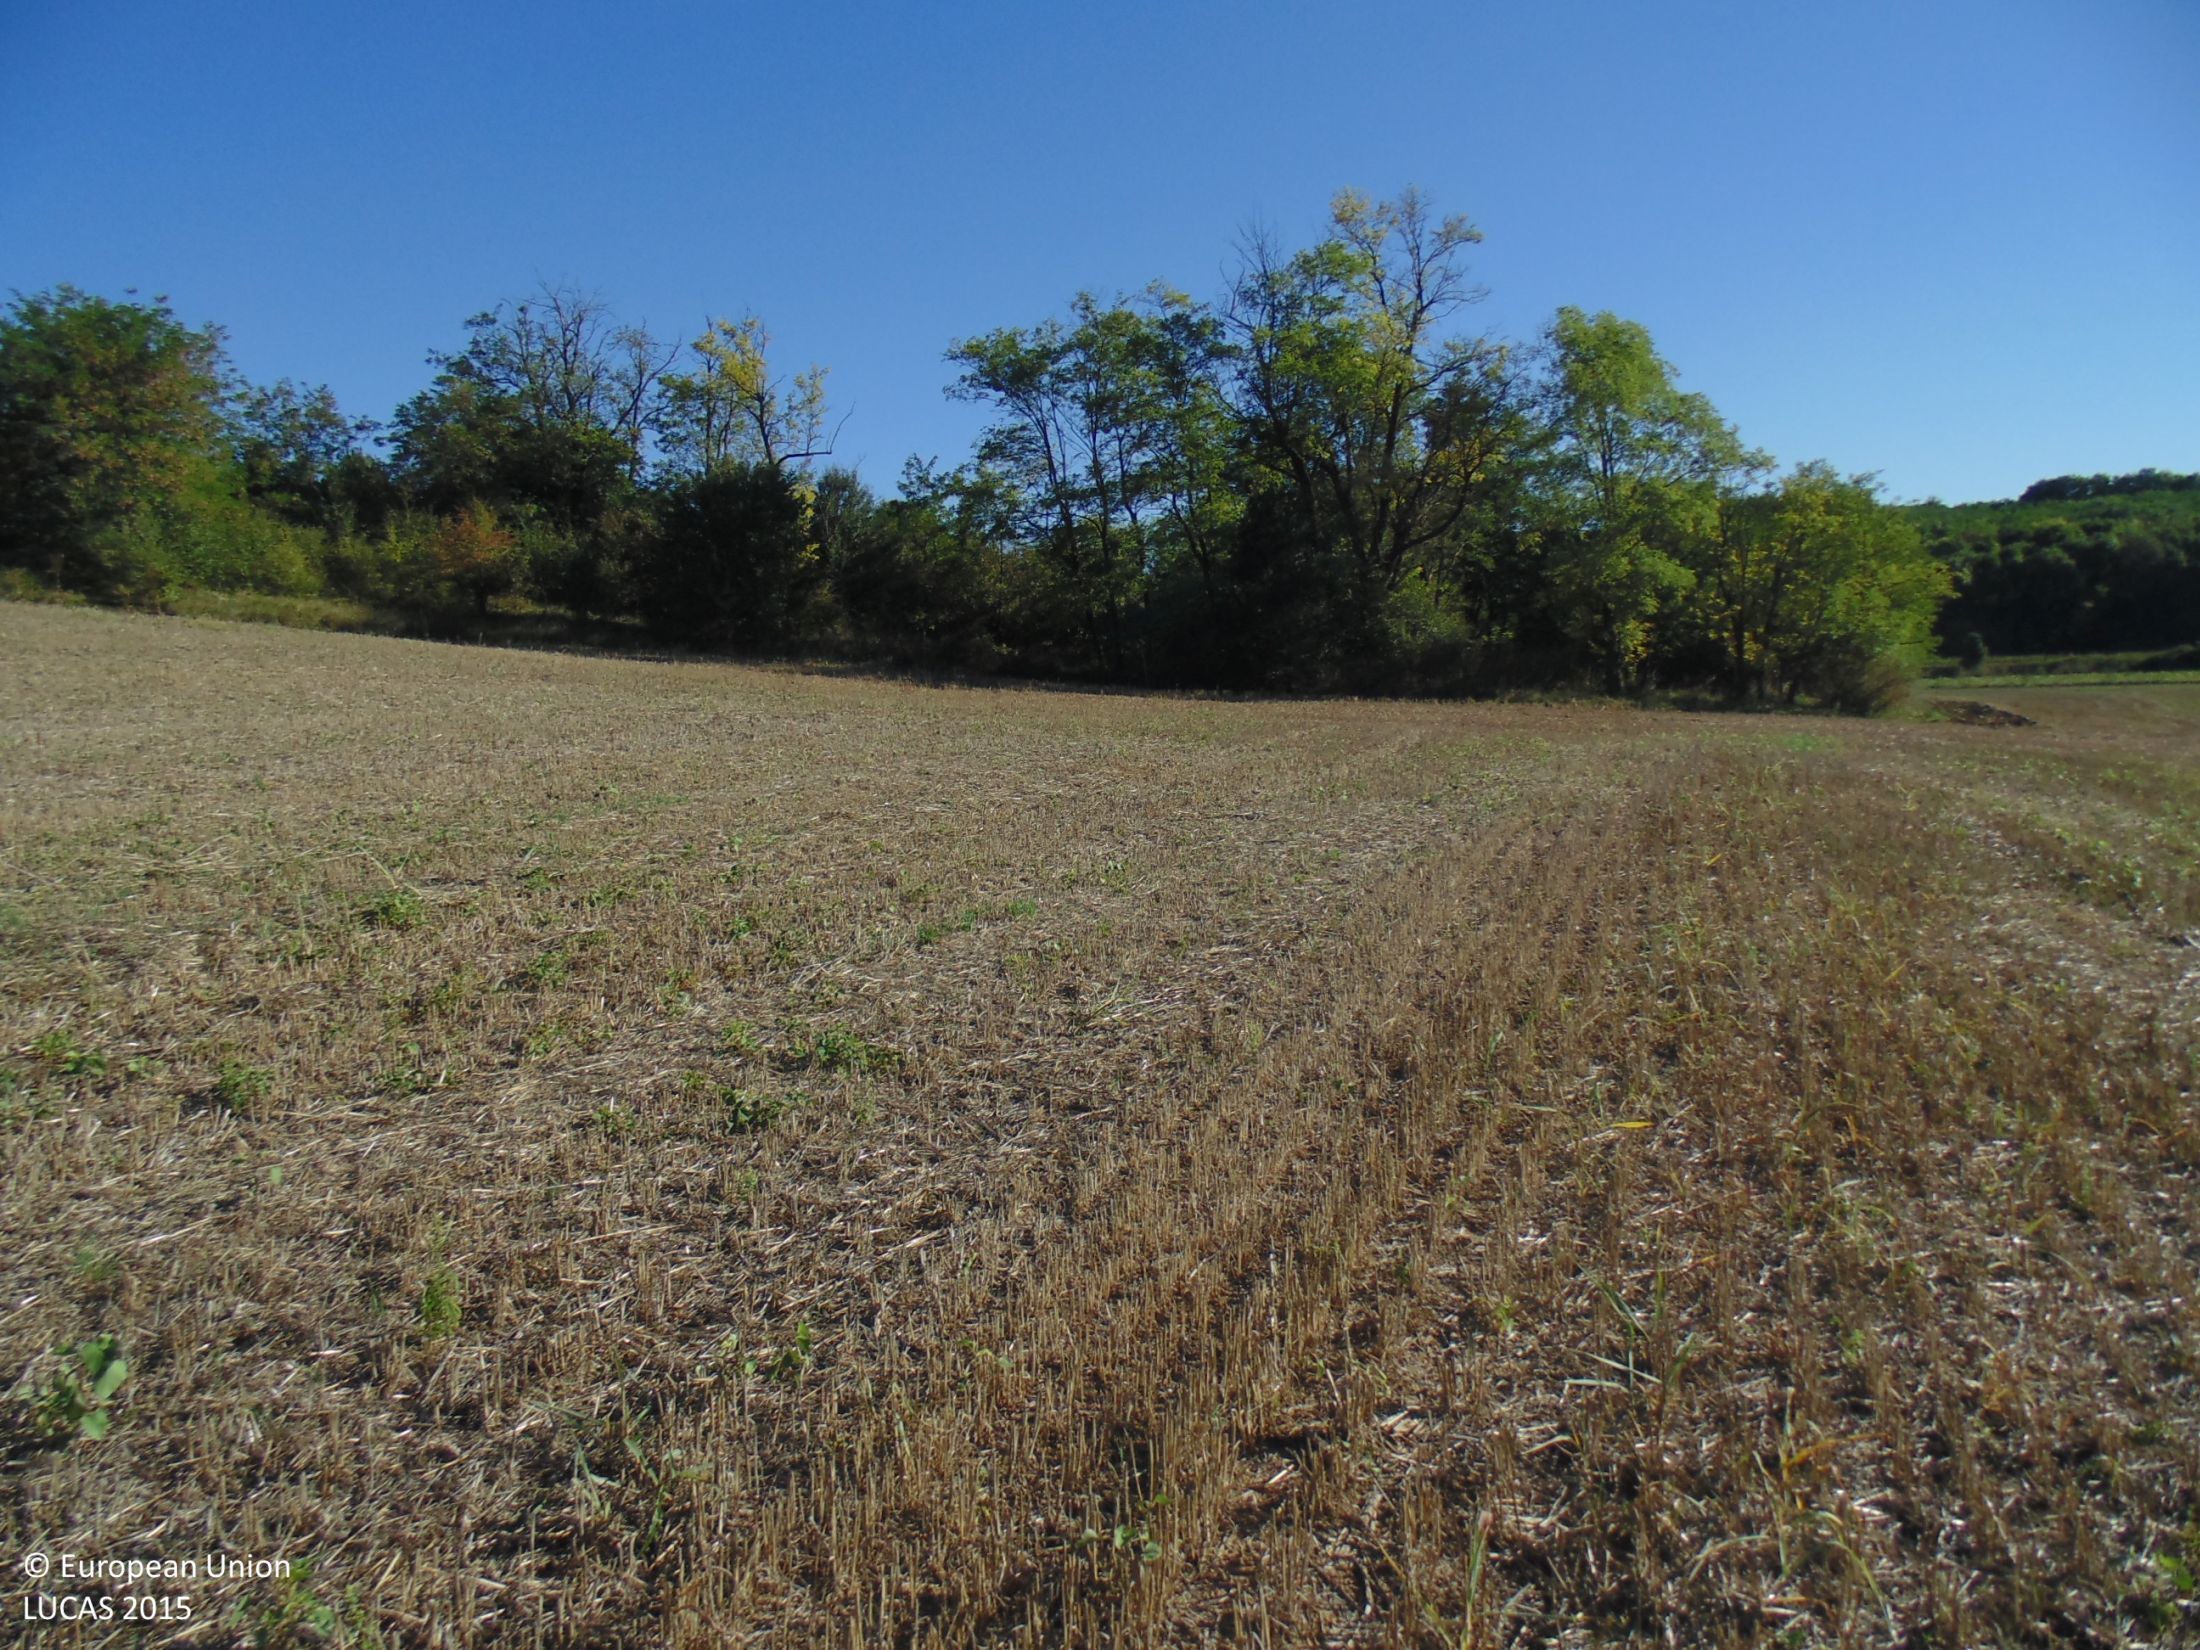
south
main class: Cropland
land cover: Common wheat
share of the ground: 25 - 50 %
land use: Agriculture (excluding fallow land and kitchen gardens)
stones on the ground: < 10 %
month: September
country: BG
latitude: 43.8004
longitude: 27.2171
